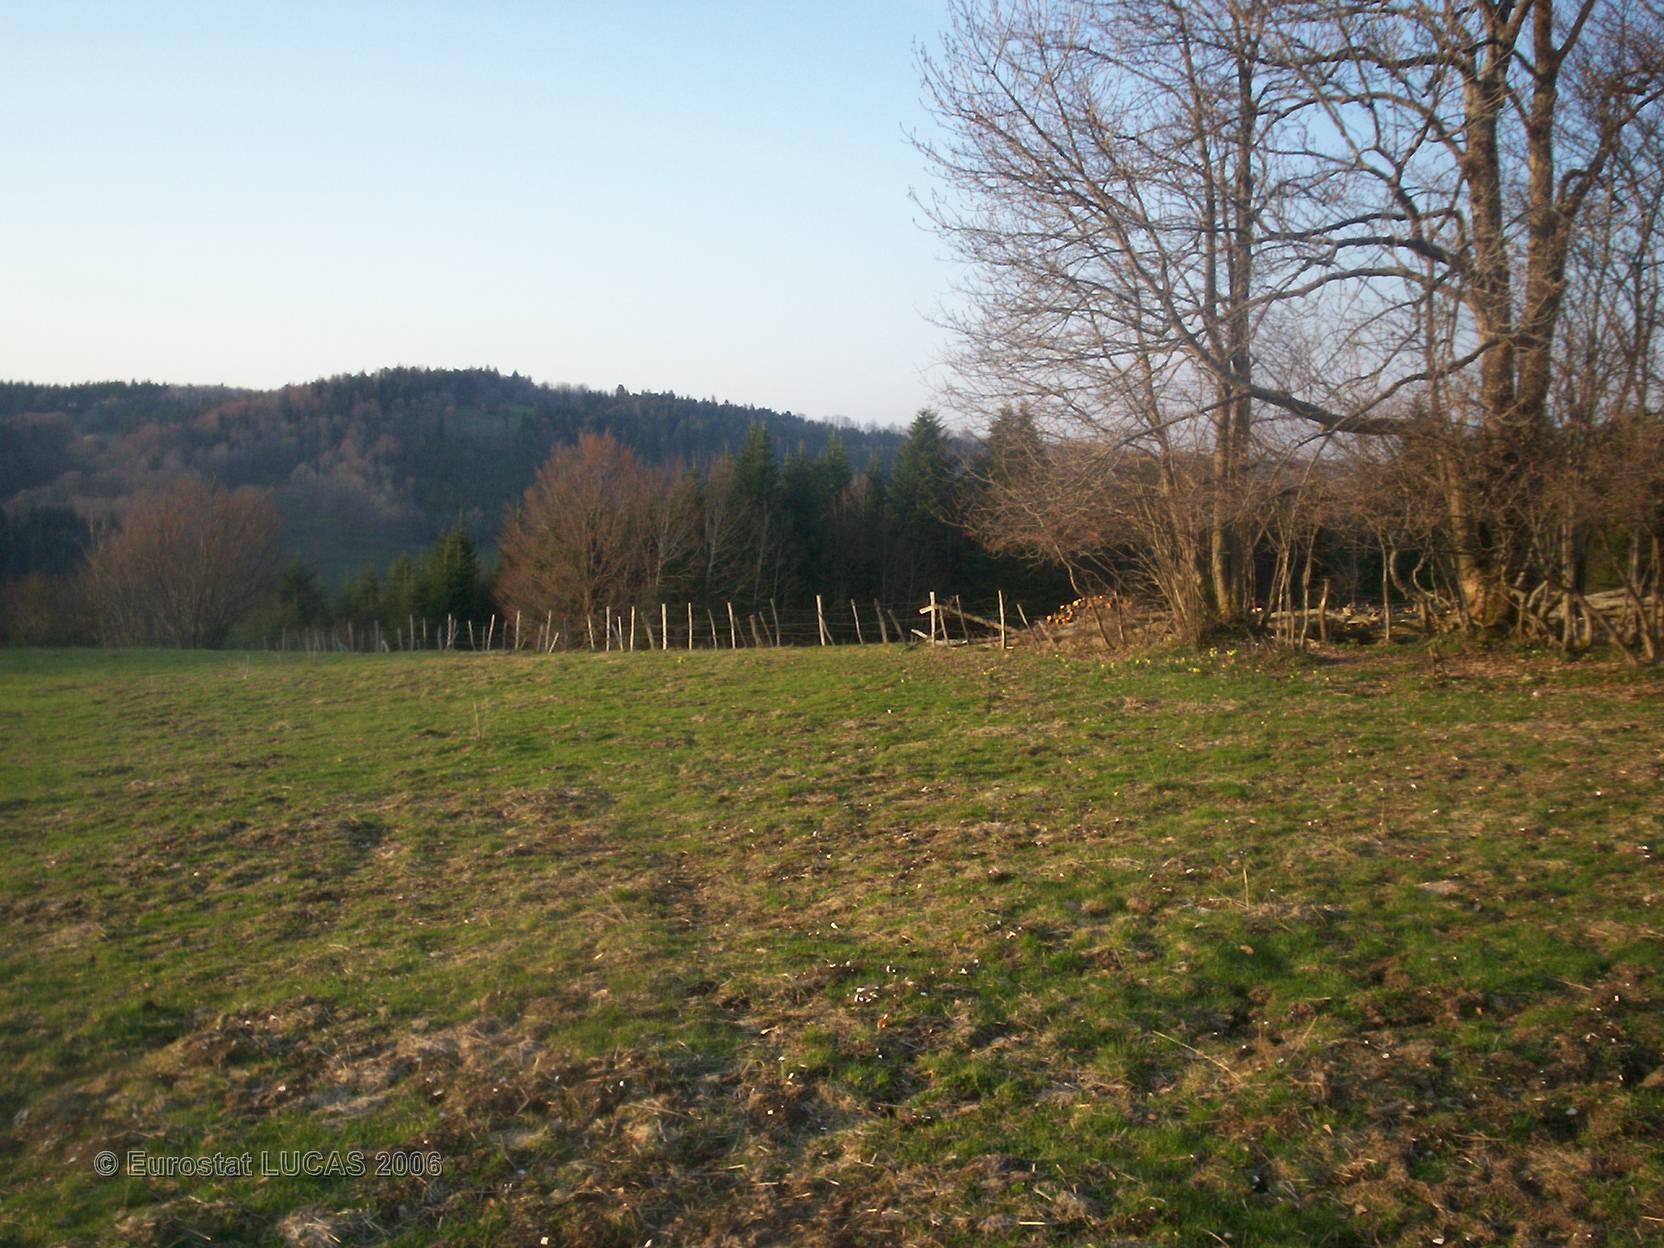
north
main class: Grassland
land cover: Grassland without tree/shrub cover
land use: Agriculture (excluding fallow land and kitchen gardens)
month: April
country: FR
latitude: 47.2800
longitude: 6.9217
